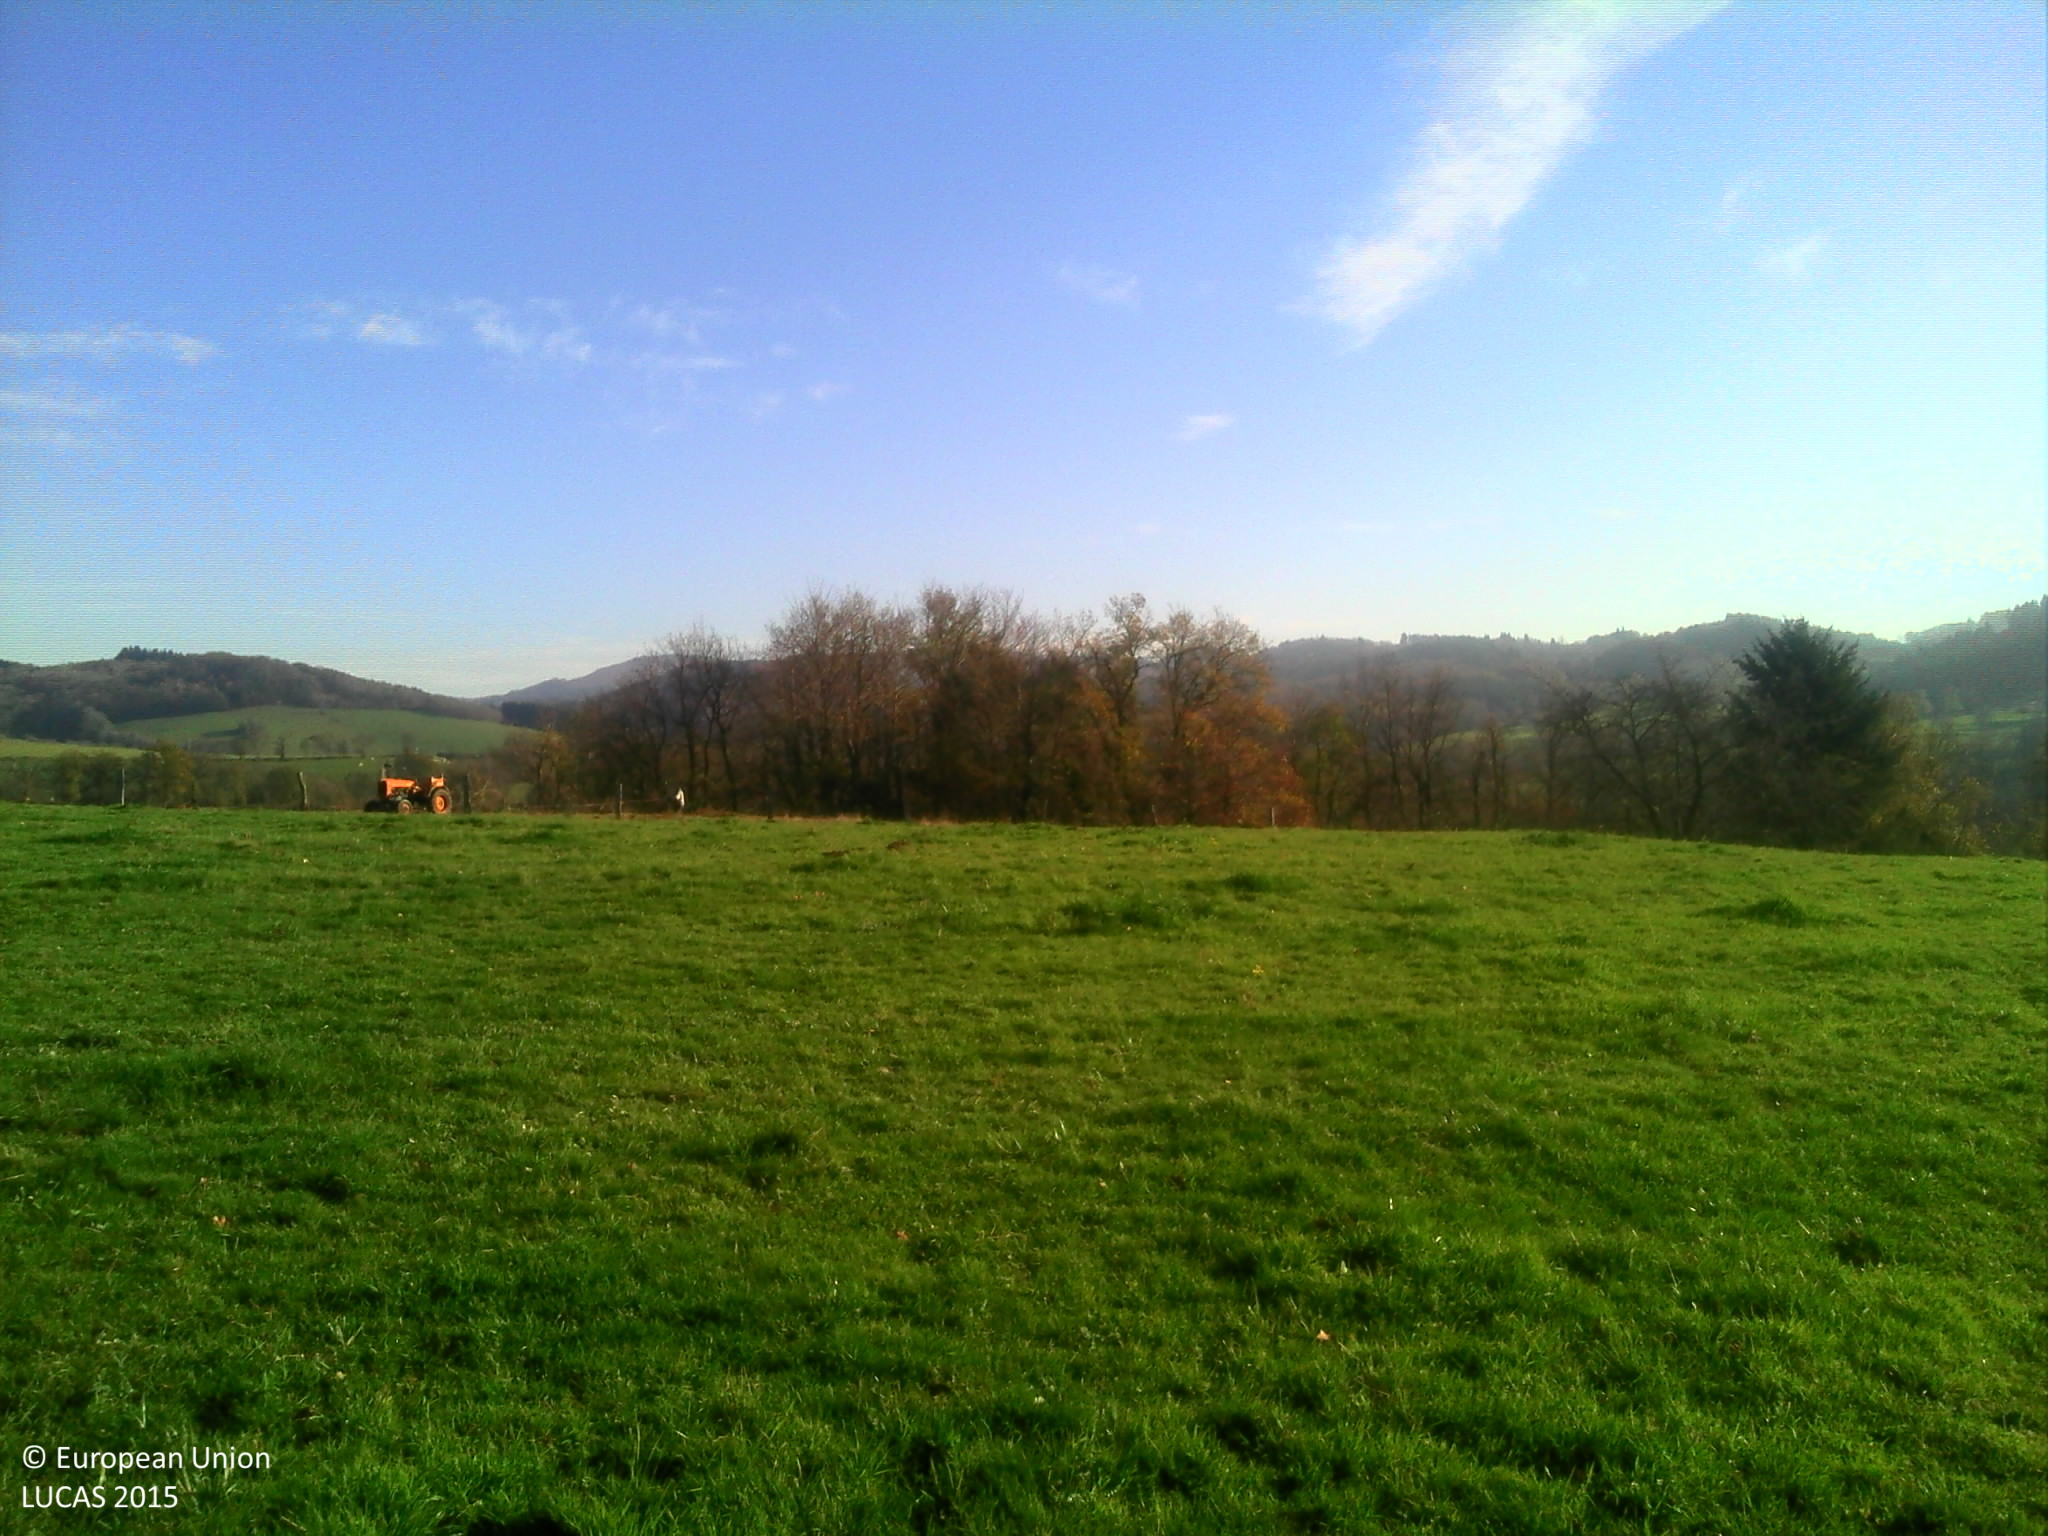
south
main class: Grassland
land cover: Grassland without tree/shrub cover
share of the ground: > 75 %
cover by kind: herbaceous plants 100 %
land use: Agriculture (excluding fallow land and kitchen gardens)
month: November
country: FR
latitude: 46.1292
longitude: 3.6974
